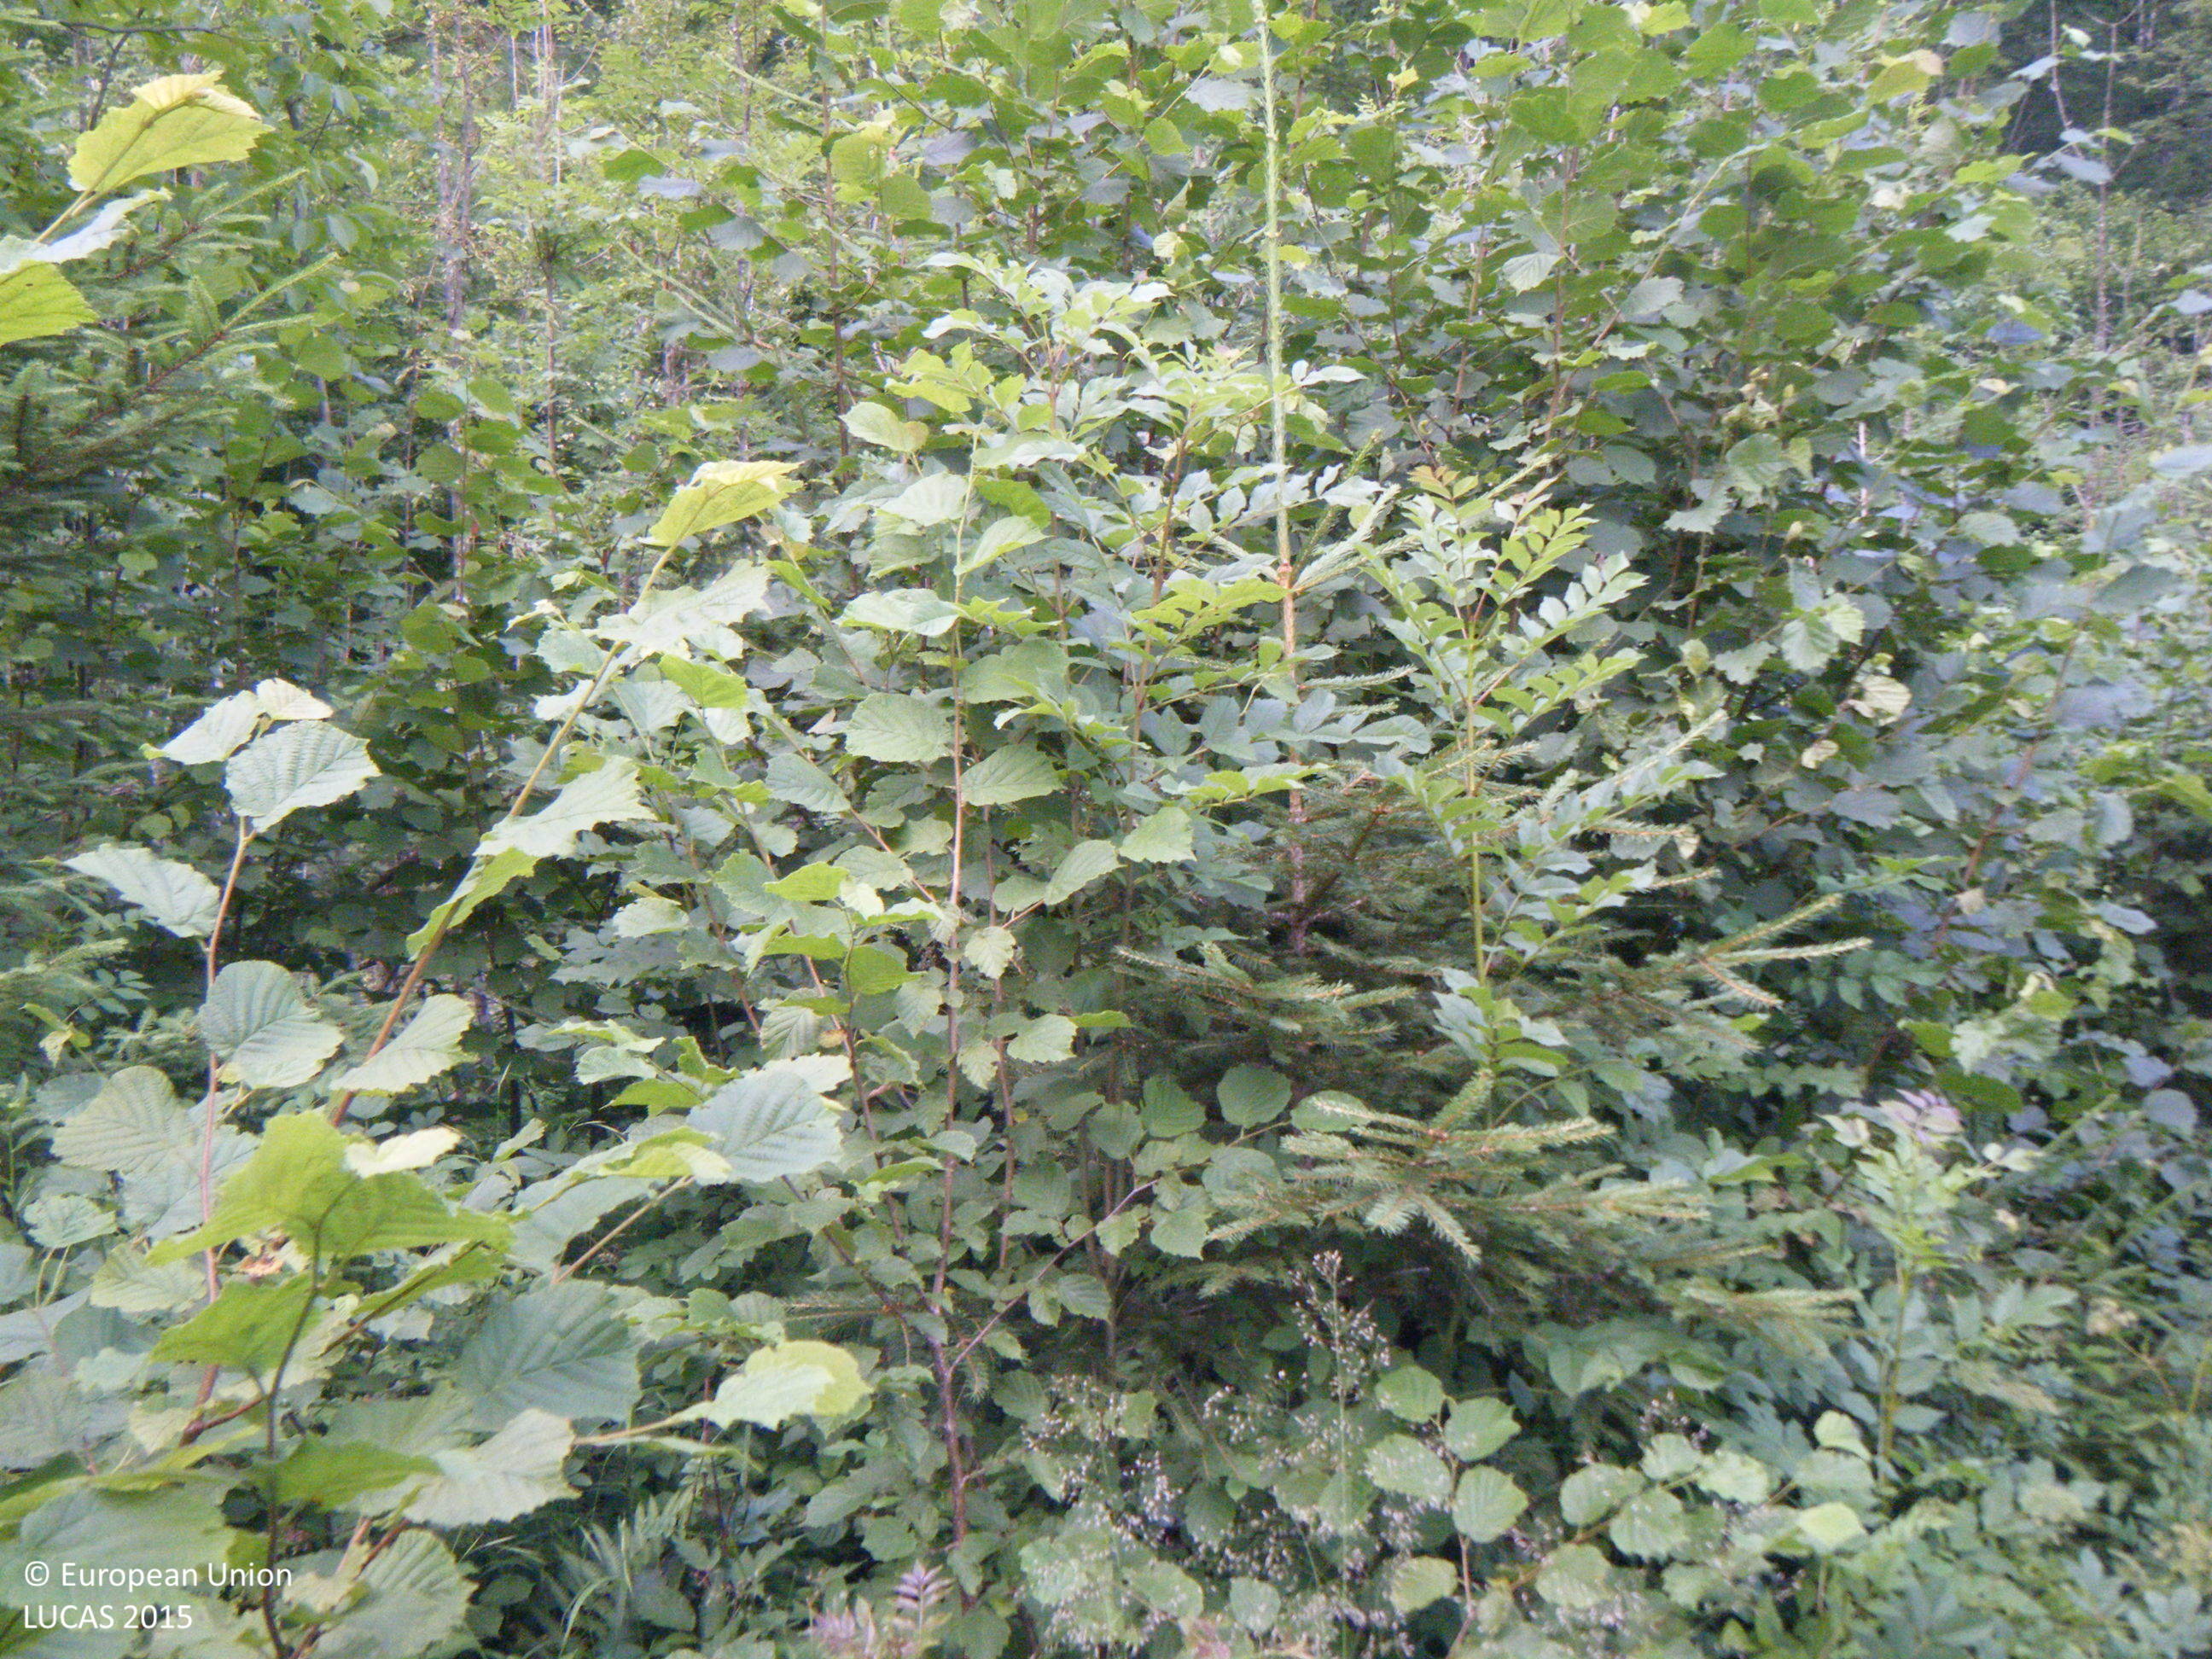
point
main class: Woodland
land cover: Spruce dominated mixed woodland
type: mesophytic deciduous forest
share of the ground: > 75 %
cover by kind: broadleaved forest trees 50 %, coniferous forest trees 25 %, shrubs 15 %, herbaceous plants 10 %
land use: Forestry
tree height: < 5 m
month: July
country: AT
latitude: 47.7347
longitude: 13.5324
